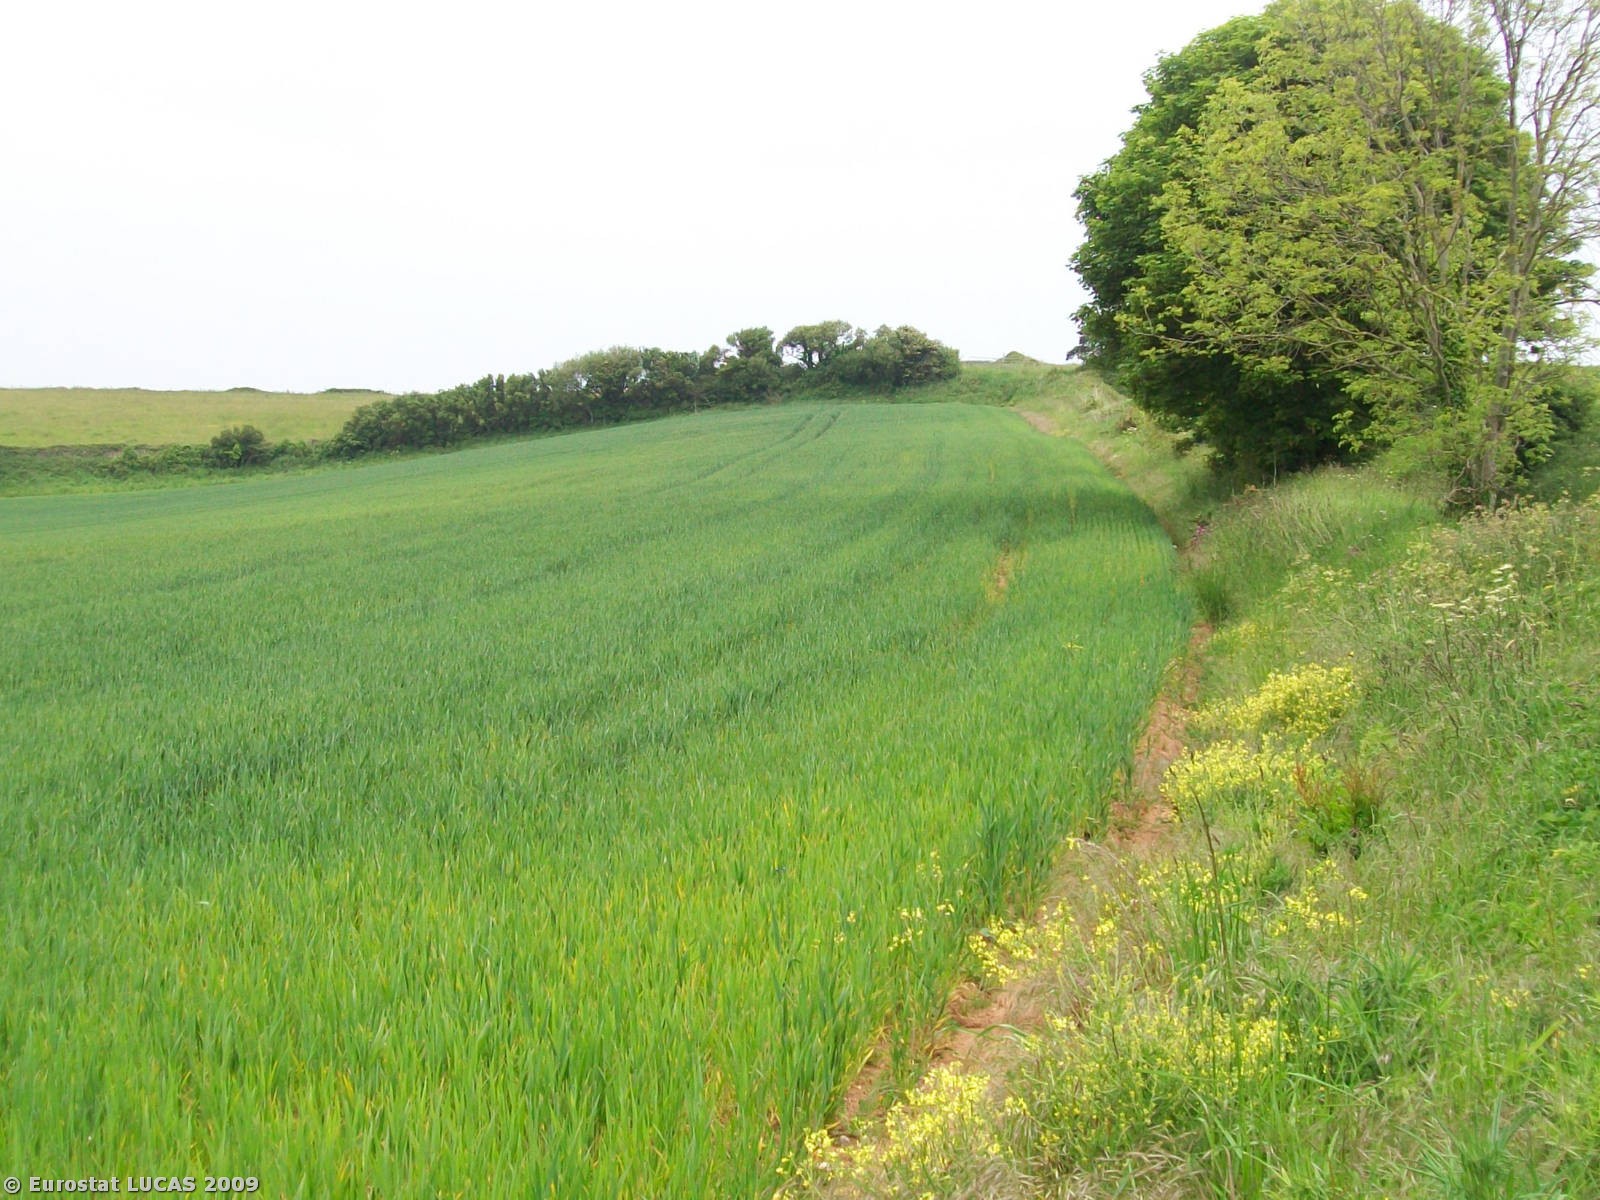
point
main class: Cropland
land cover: Common wheat
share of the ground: 50 - 75 %
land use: Agriculture (excluding fallow land and kitchen gardens)
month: May
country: GB
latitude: 50.6401
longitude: -3.3013
